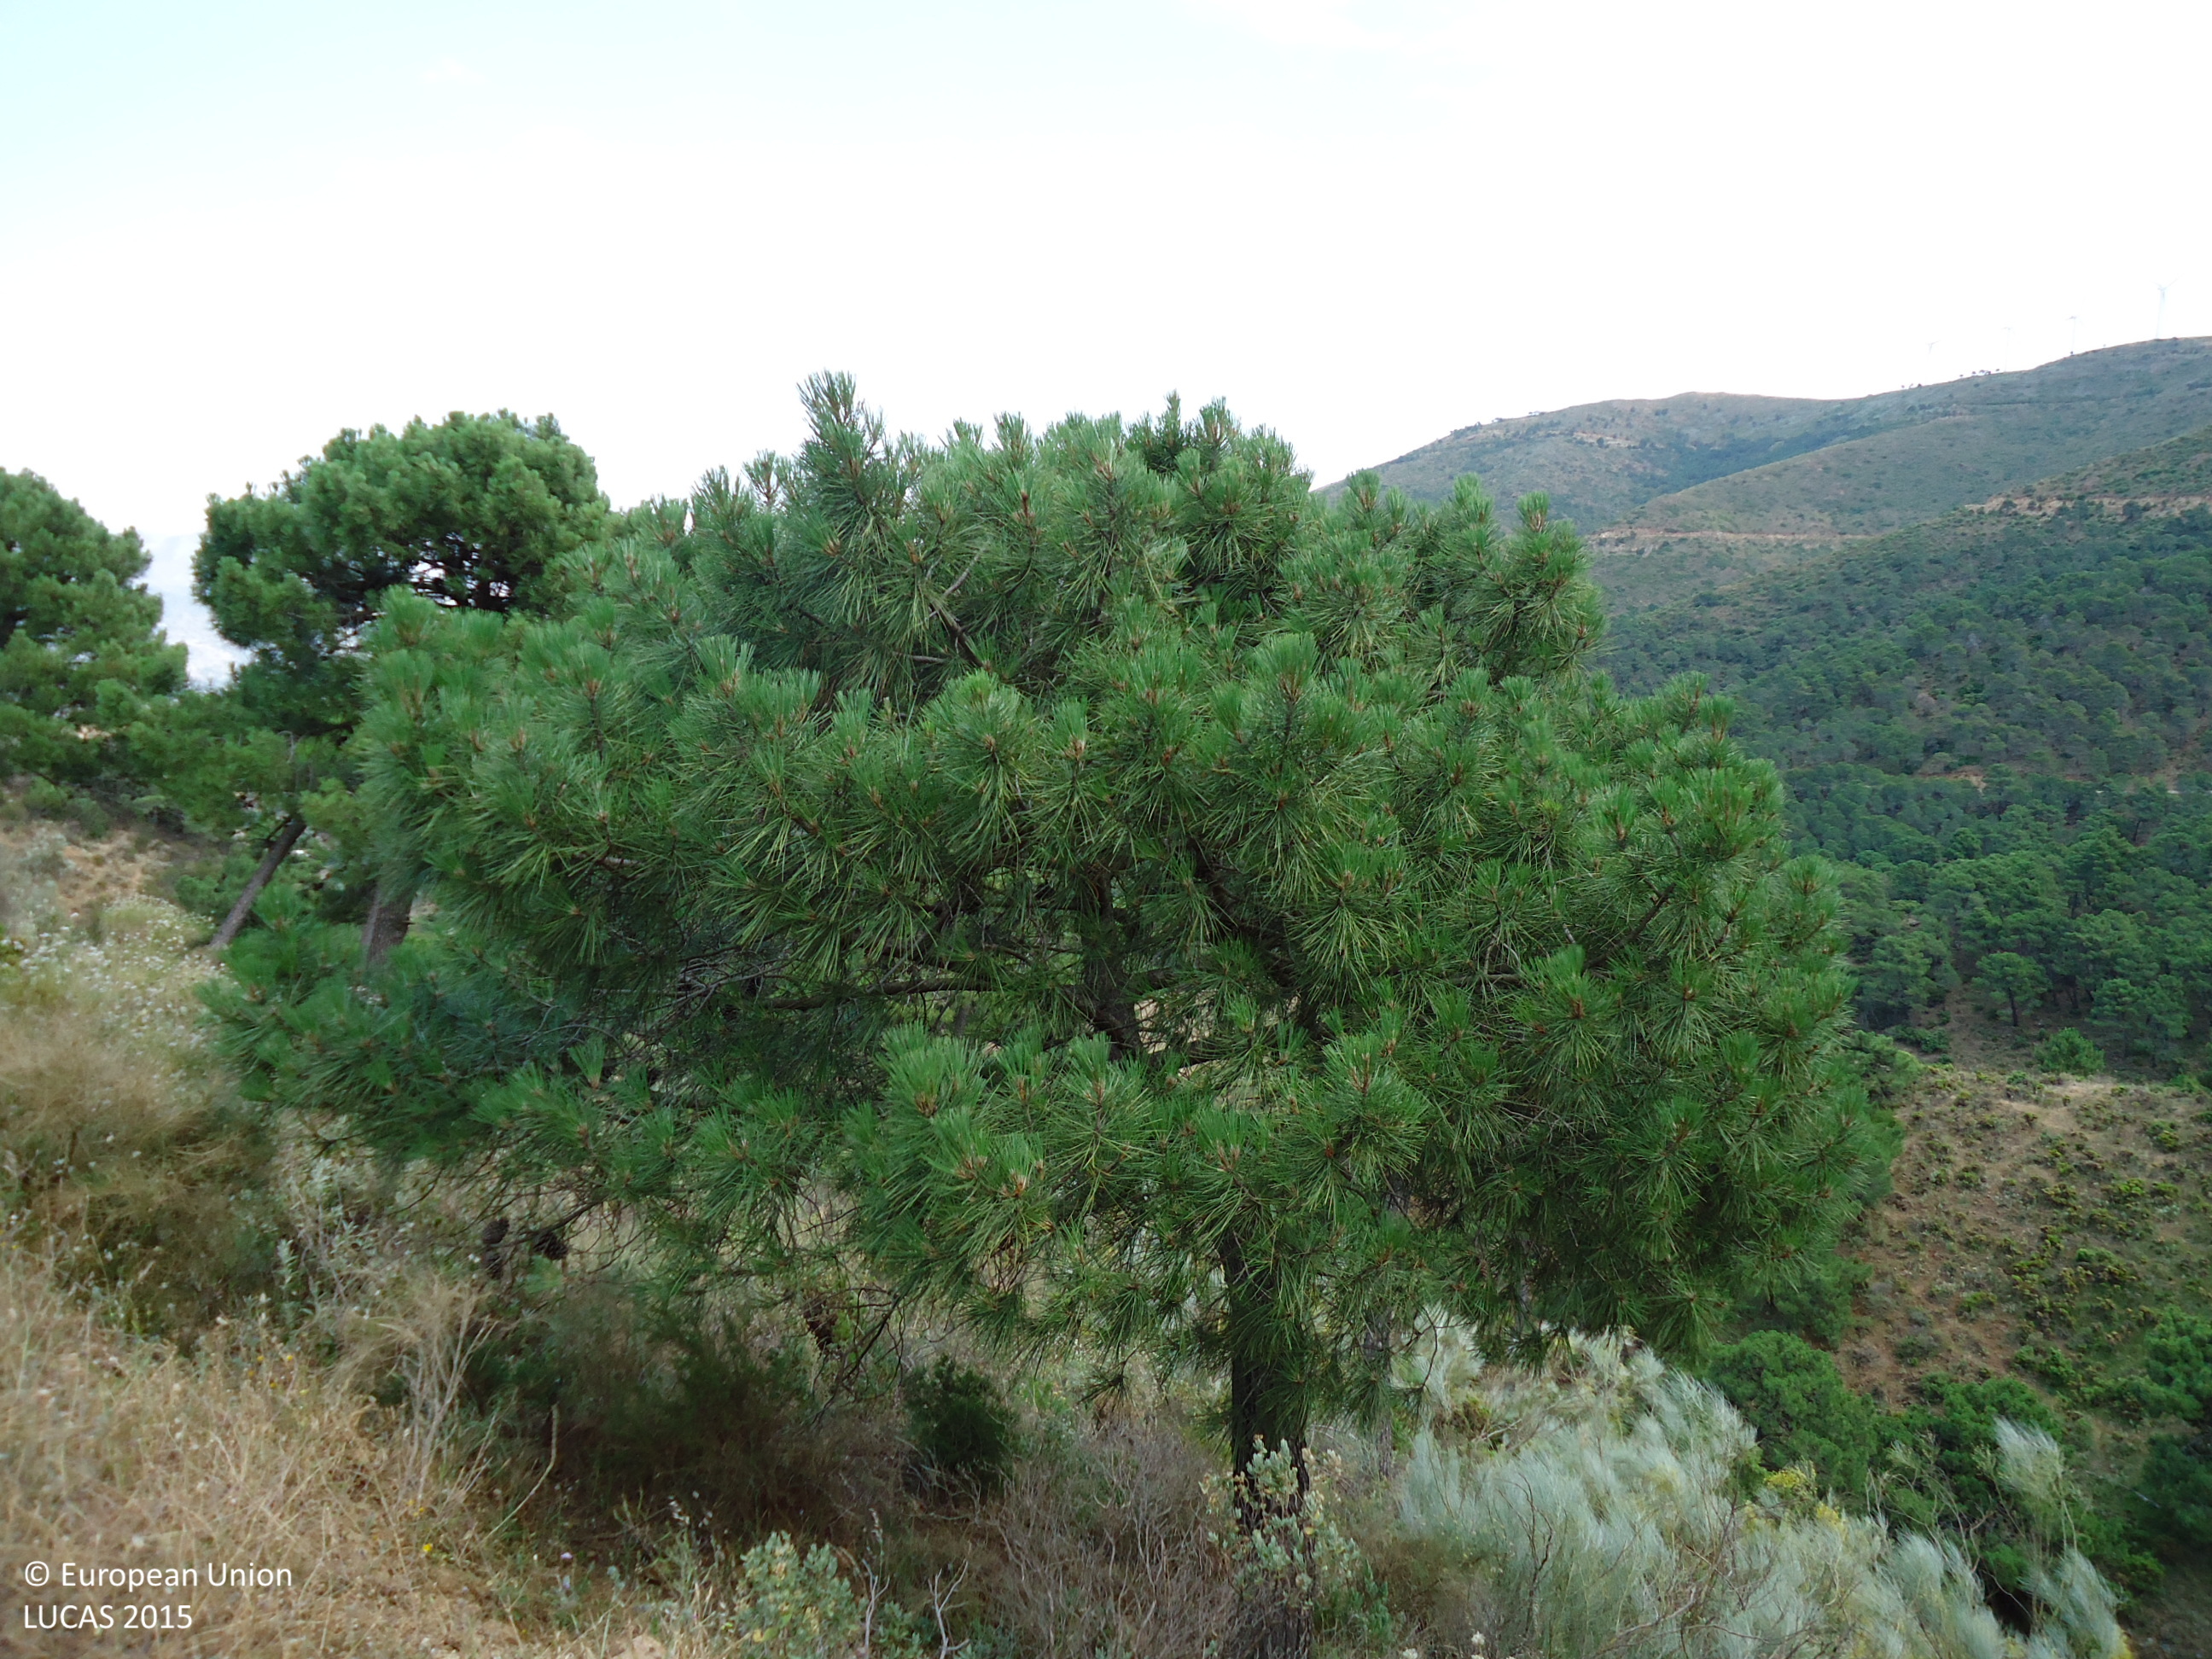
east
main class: Woodland
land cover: Pine dominated coniferous woodland
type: coniferous forest of the mediterranean region
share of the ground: 25 - 50 %
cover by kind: shrubs 75 %, coniferous forest trees 25 %
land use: Forestry
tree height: > 5 m
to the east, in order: Pine dominated coniferous woodland; Shrubland with sparse tree cover; Tracks; Shrubland with sparse tree cover; Rivers and streams; Pine dominated coniferous woodland
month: June
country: ES
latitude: 36.8600
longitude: -4.7912
